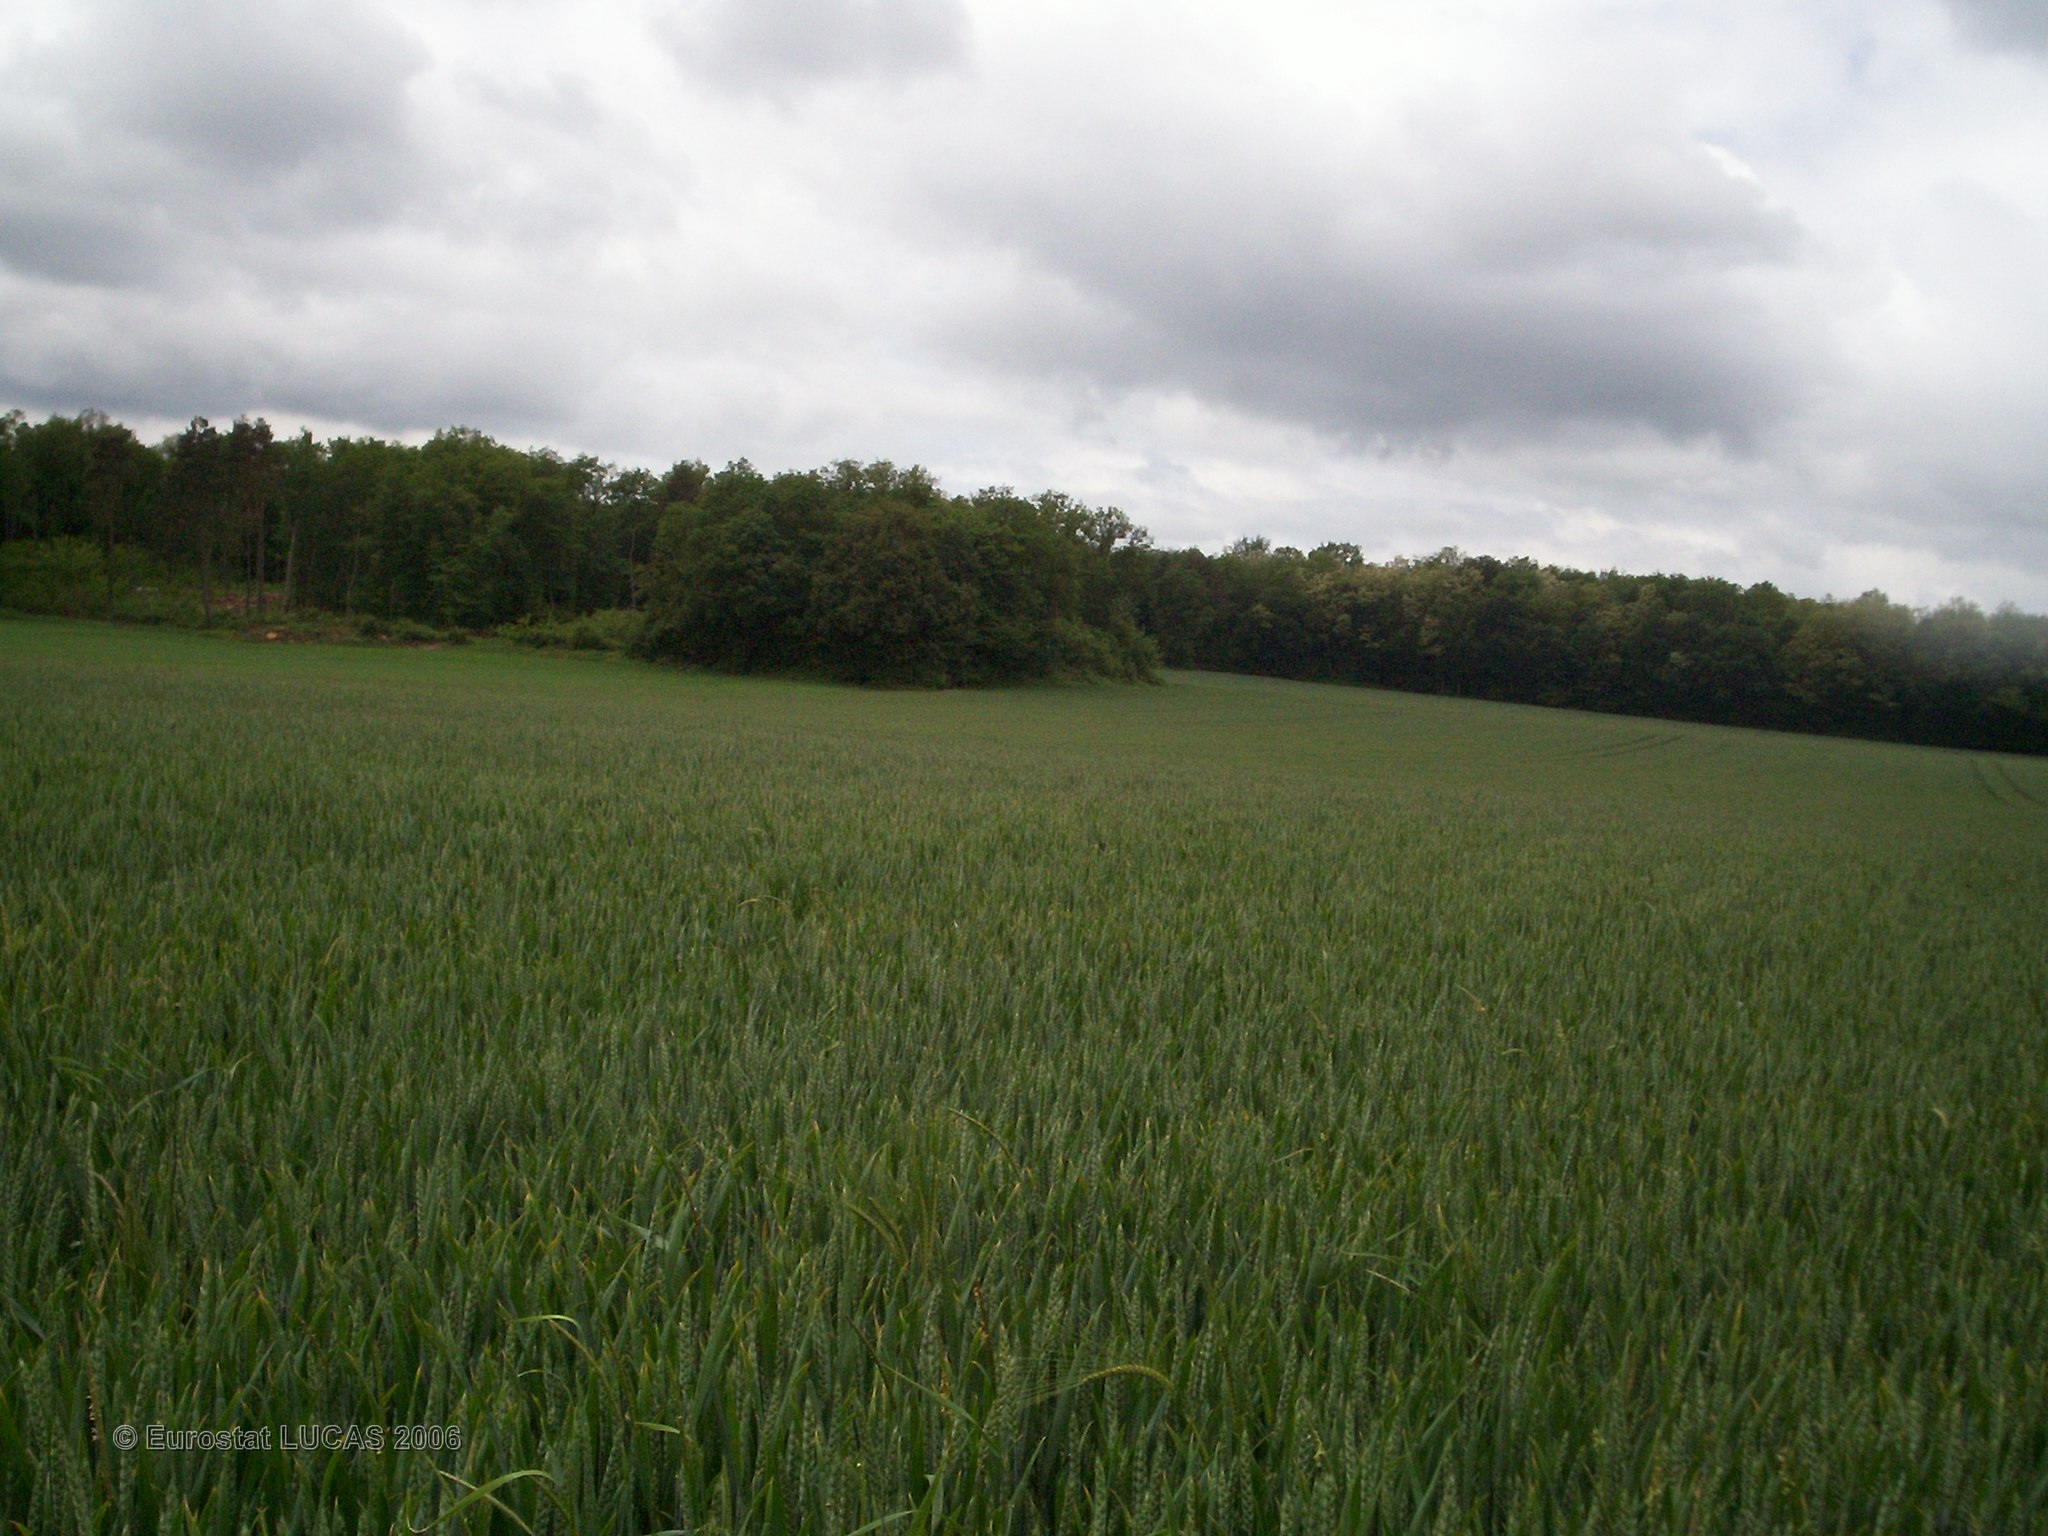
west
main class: Cropland
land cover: Common wheat
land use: Agriculture (excluding fallow land and kitchen gardens)
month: May
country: FR
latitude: 47.6089
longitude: 3.9980
